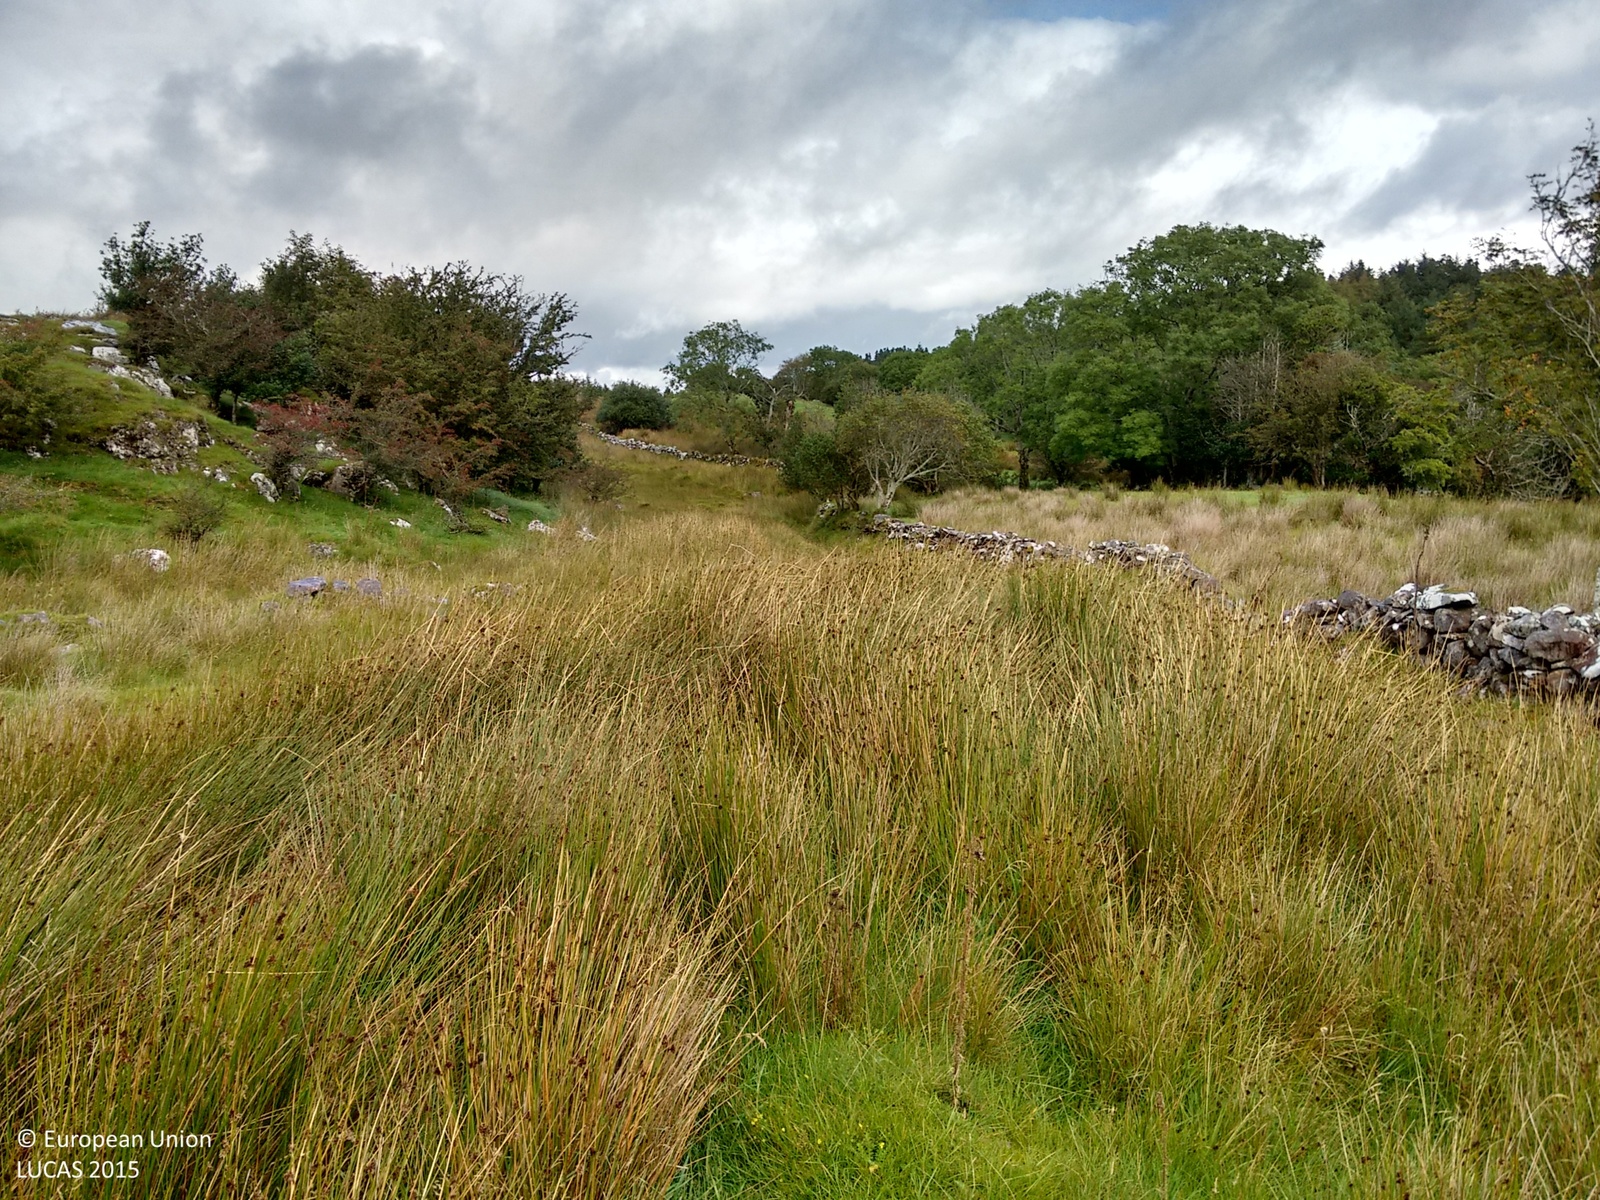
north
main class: Shrubland
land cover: Shrubland without tree cover
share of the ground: > 75 %
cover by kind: shrubs 60 %, lichens and mosses 30 %, herbaceous plants 10 %
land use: Agriculture (excluding fallow land and kitchen gardens)
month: September
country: IE
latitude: 54.0064
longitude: -9.3436
